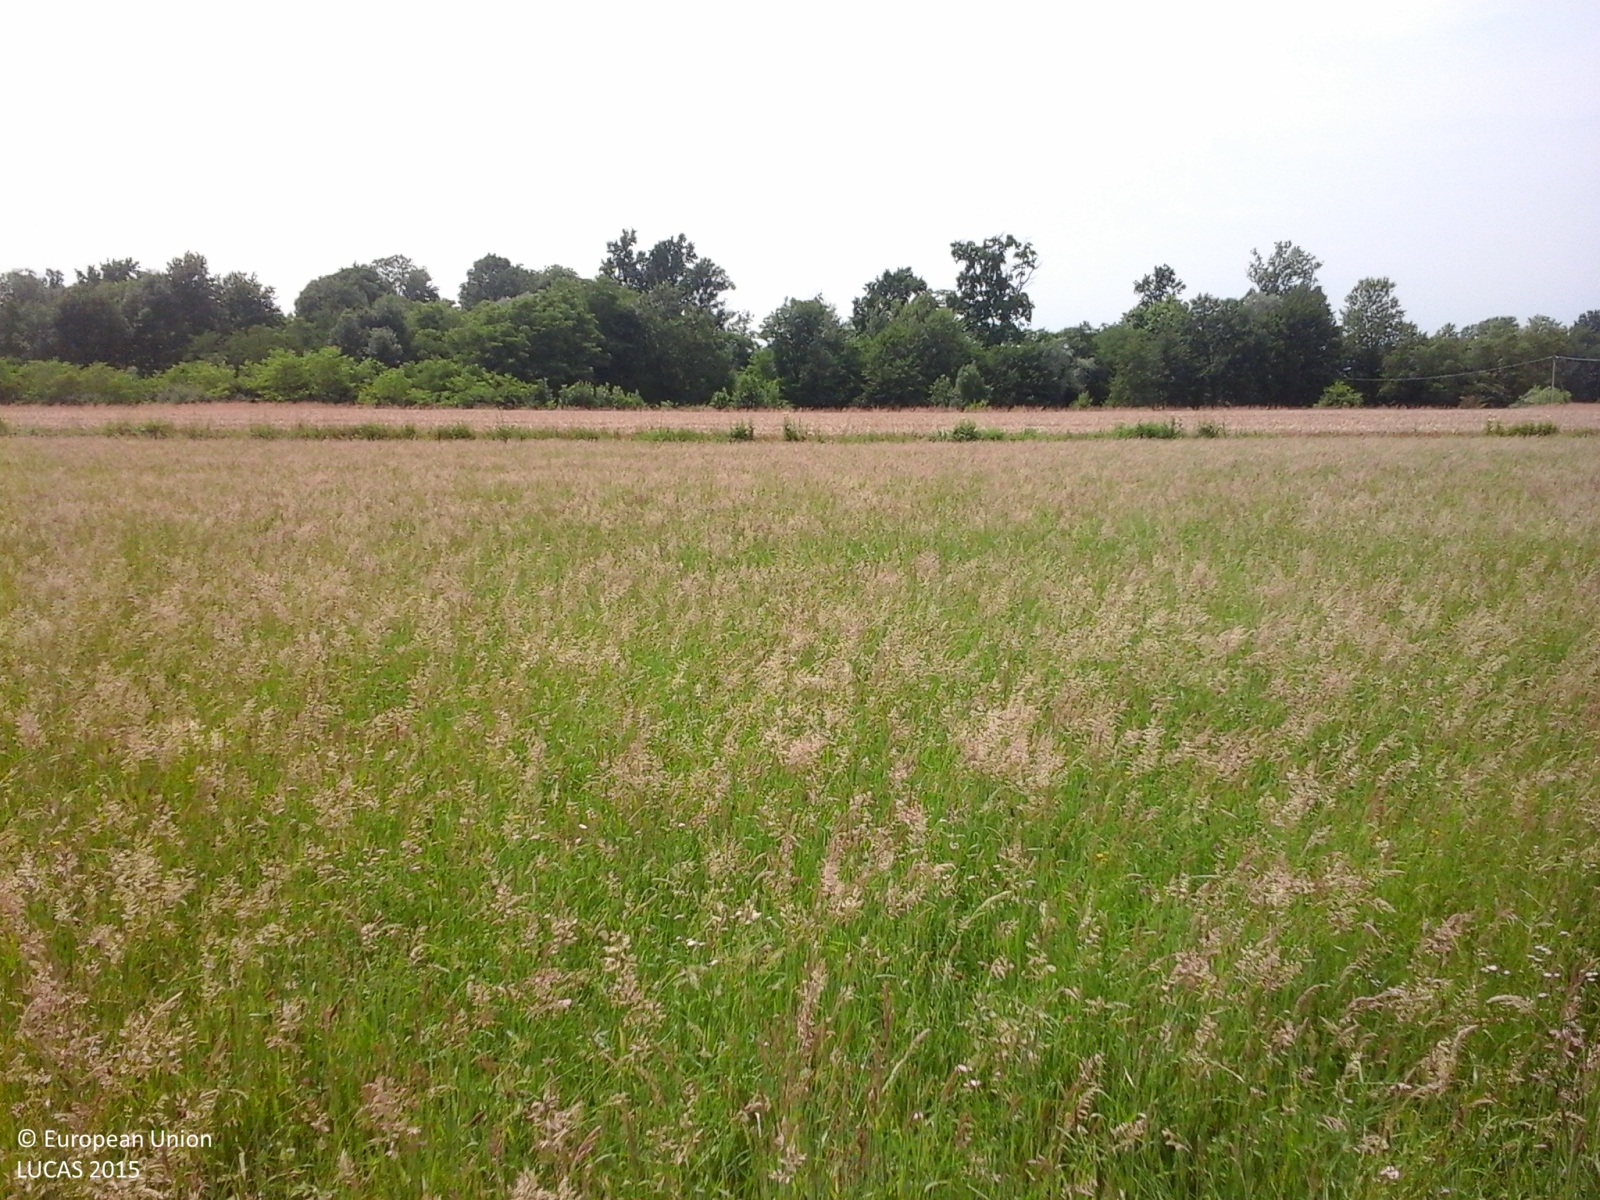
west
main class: Grassland
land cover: Grassland without tree/shrub cover
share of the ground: > 75 %
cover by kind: herbaceous plants 100 %
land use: Agriculture (excluding fallow land and kitchen gardens)
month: June
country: IT
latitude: 45.3192
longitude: 7.7967
